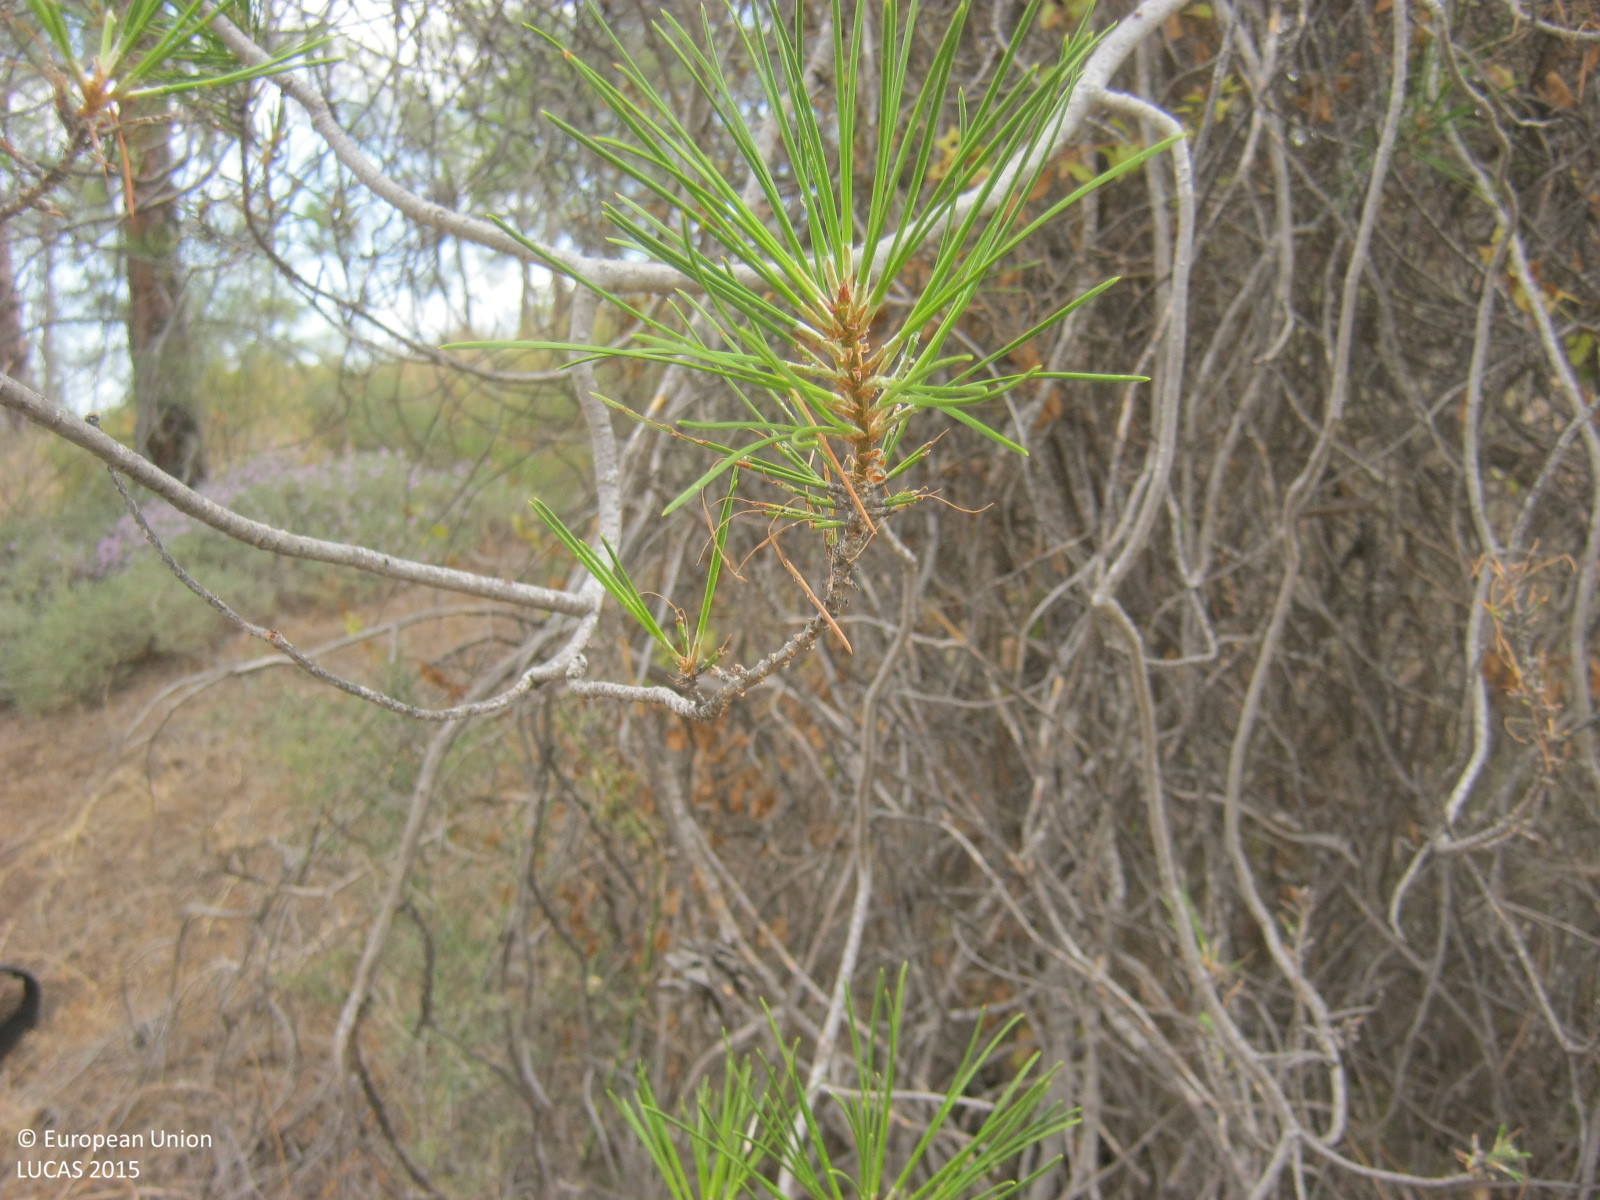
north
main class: Woodland
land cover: Pine dominated coniferous woodland
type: coniferous forest of the mediterranean region
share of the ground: 50 - 75 %
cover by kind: coniferous forest trees 70 %, shrubs 15 %, herbaceous plants 15 %
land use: Forestry
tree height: > 5 m
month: June
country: CY
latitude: 35.0691
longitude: 32.9506
